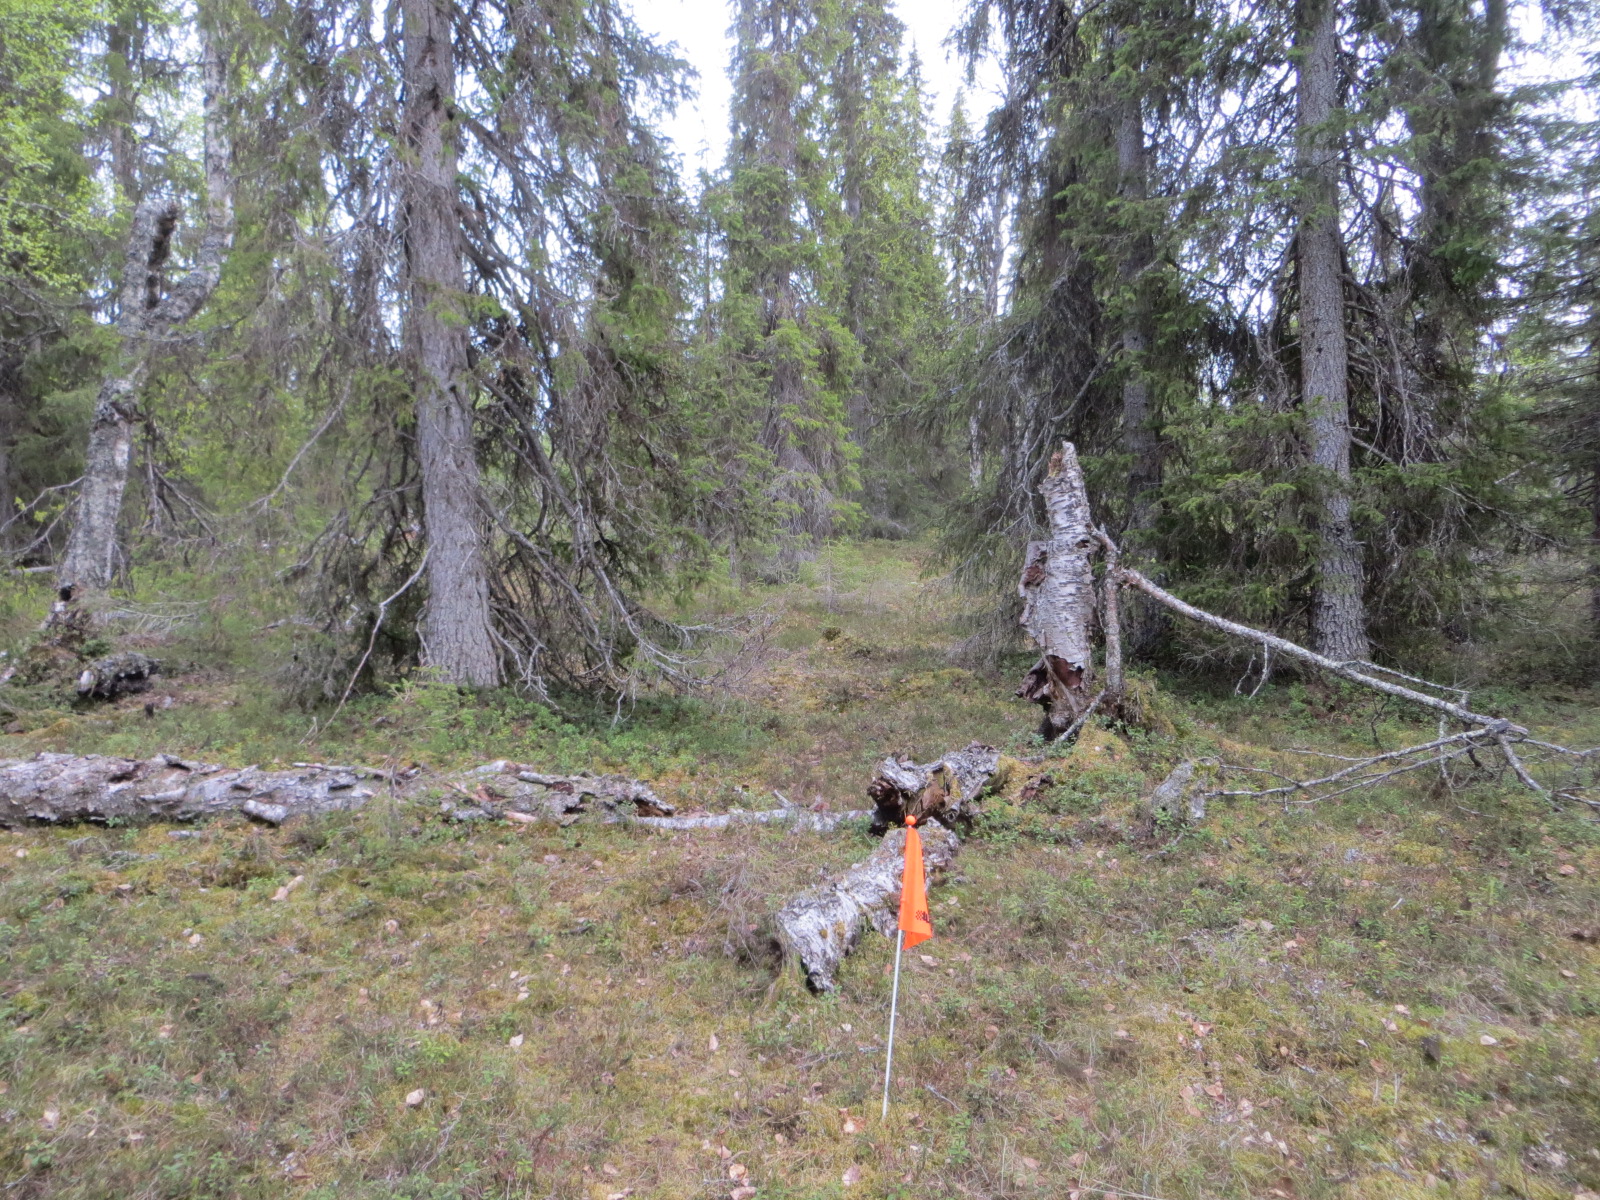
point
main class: Woodland
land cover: Spruce dominated mixed woodland
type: boreal forest
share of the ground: 50 - 75 %
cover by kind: coniferous forest trees 50 %, shrubs 25 %, broadleaved forest trees 20 %, lichens and mosses 5 %
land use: Semi-natural and natural areas not in use
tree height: > 5 m
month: June
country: FI
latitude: 67.9613
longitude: 26.1758
